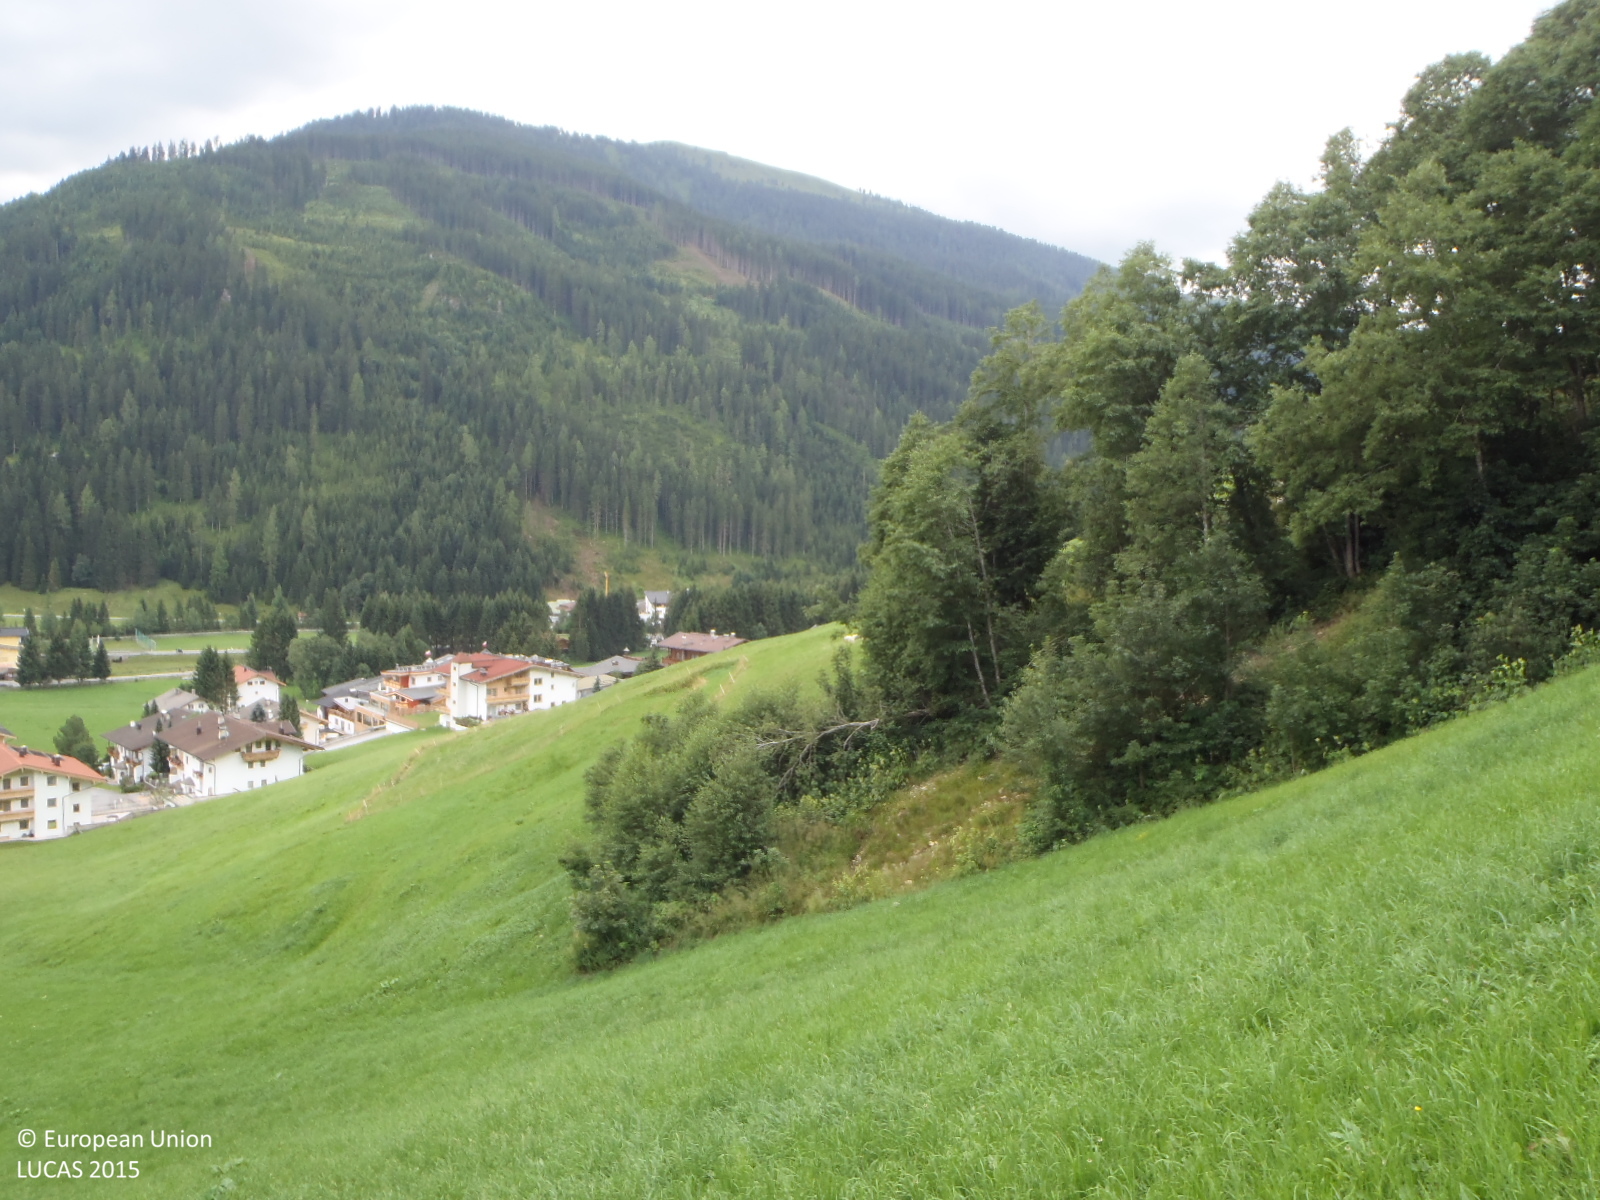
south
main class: Grassland
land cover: Grassland without tree/shrub cover
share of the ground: > 75 %
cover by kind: herbaceous plants 100 %
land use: Agriculture (excluding fallow land and kitchen gardens)
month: July
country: AT
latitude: 47.2323
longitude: 12.0456
